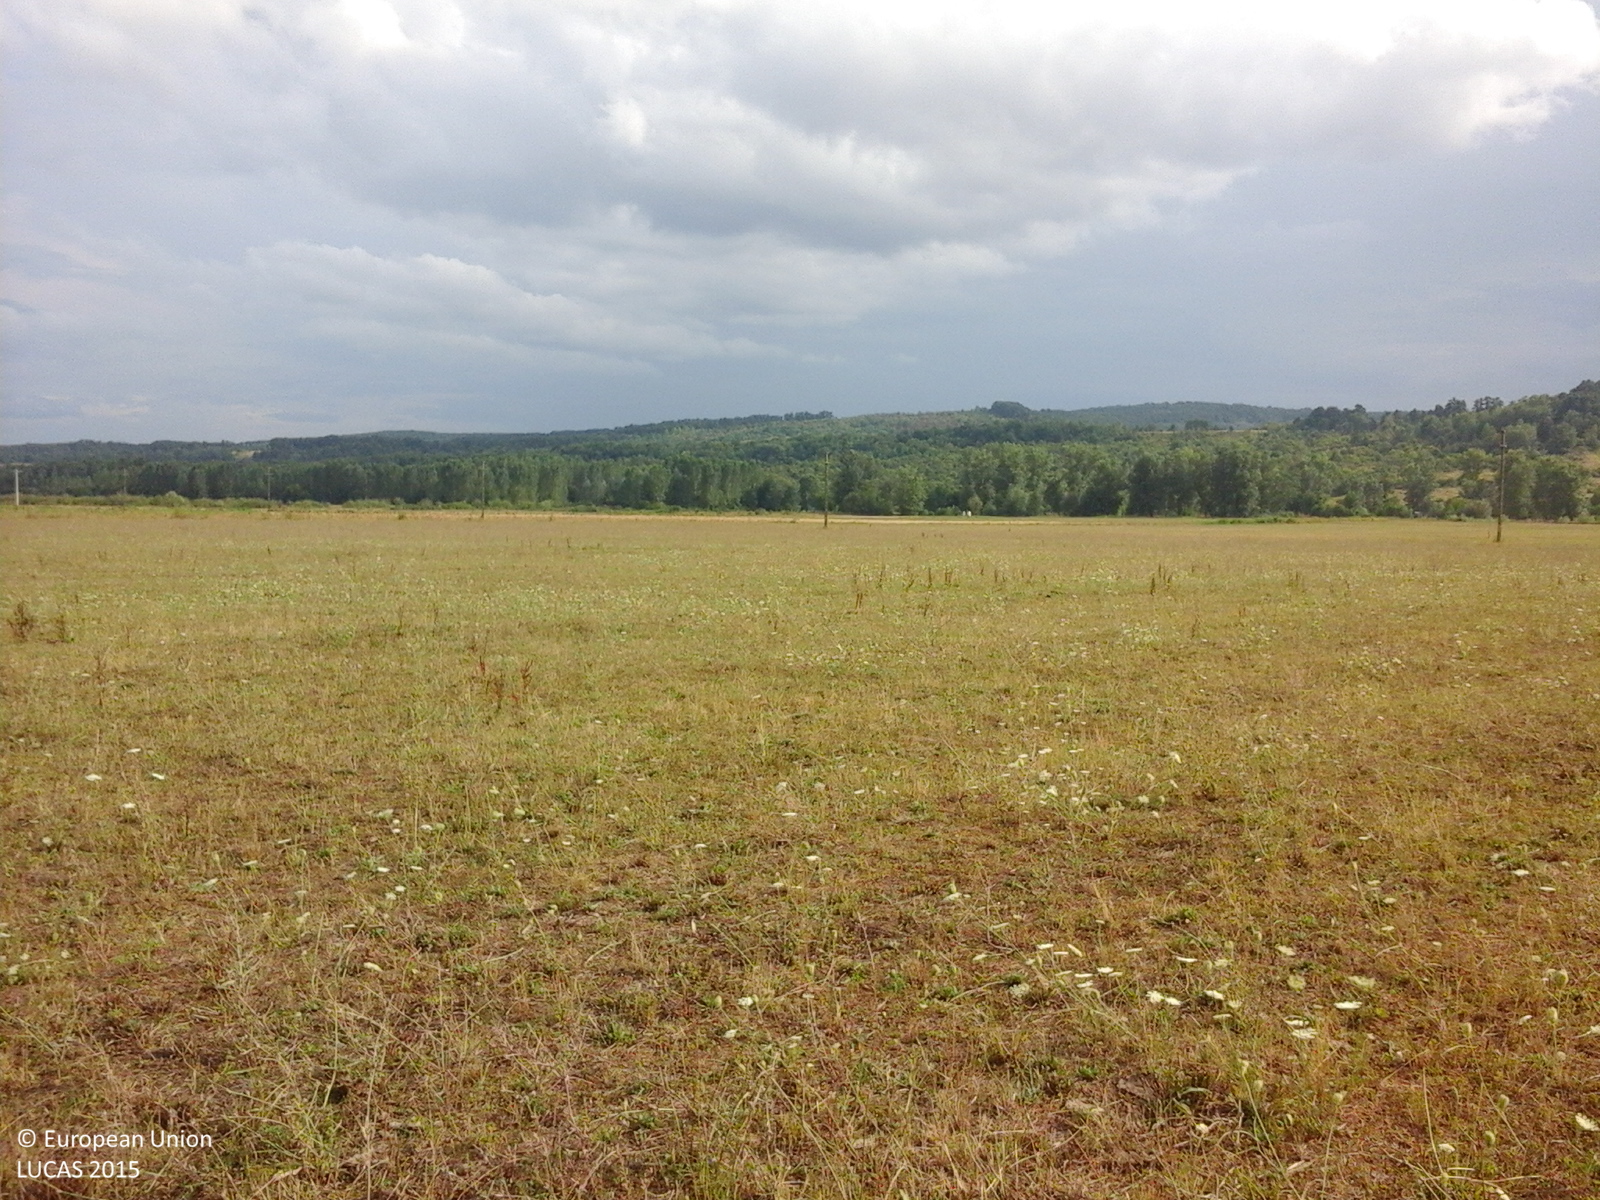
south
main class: Grassland
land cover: Grassland without tree/shrub cover
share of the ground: > 75 %
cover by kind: herbaceous plants 100 %
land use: Agriculture (excluding fallow land and kitchen gardens)
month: August
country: RO
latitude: 44.7946
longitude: 22.7993
